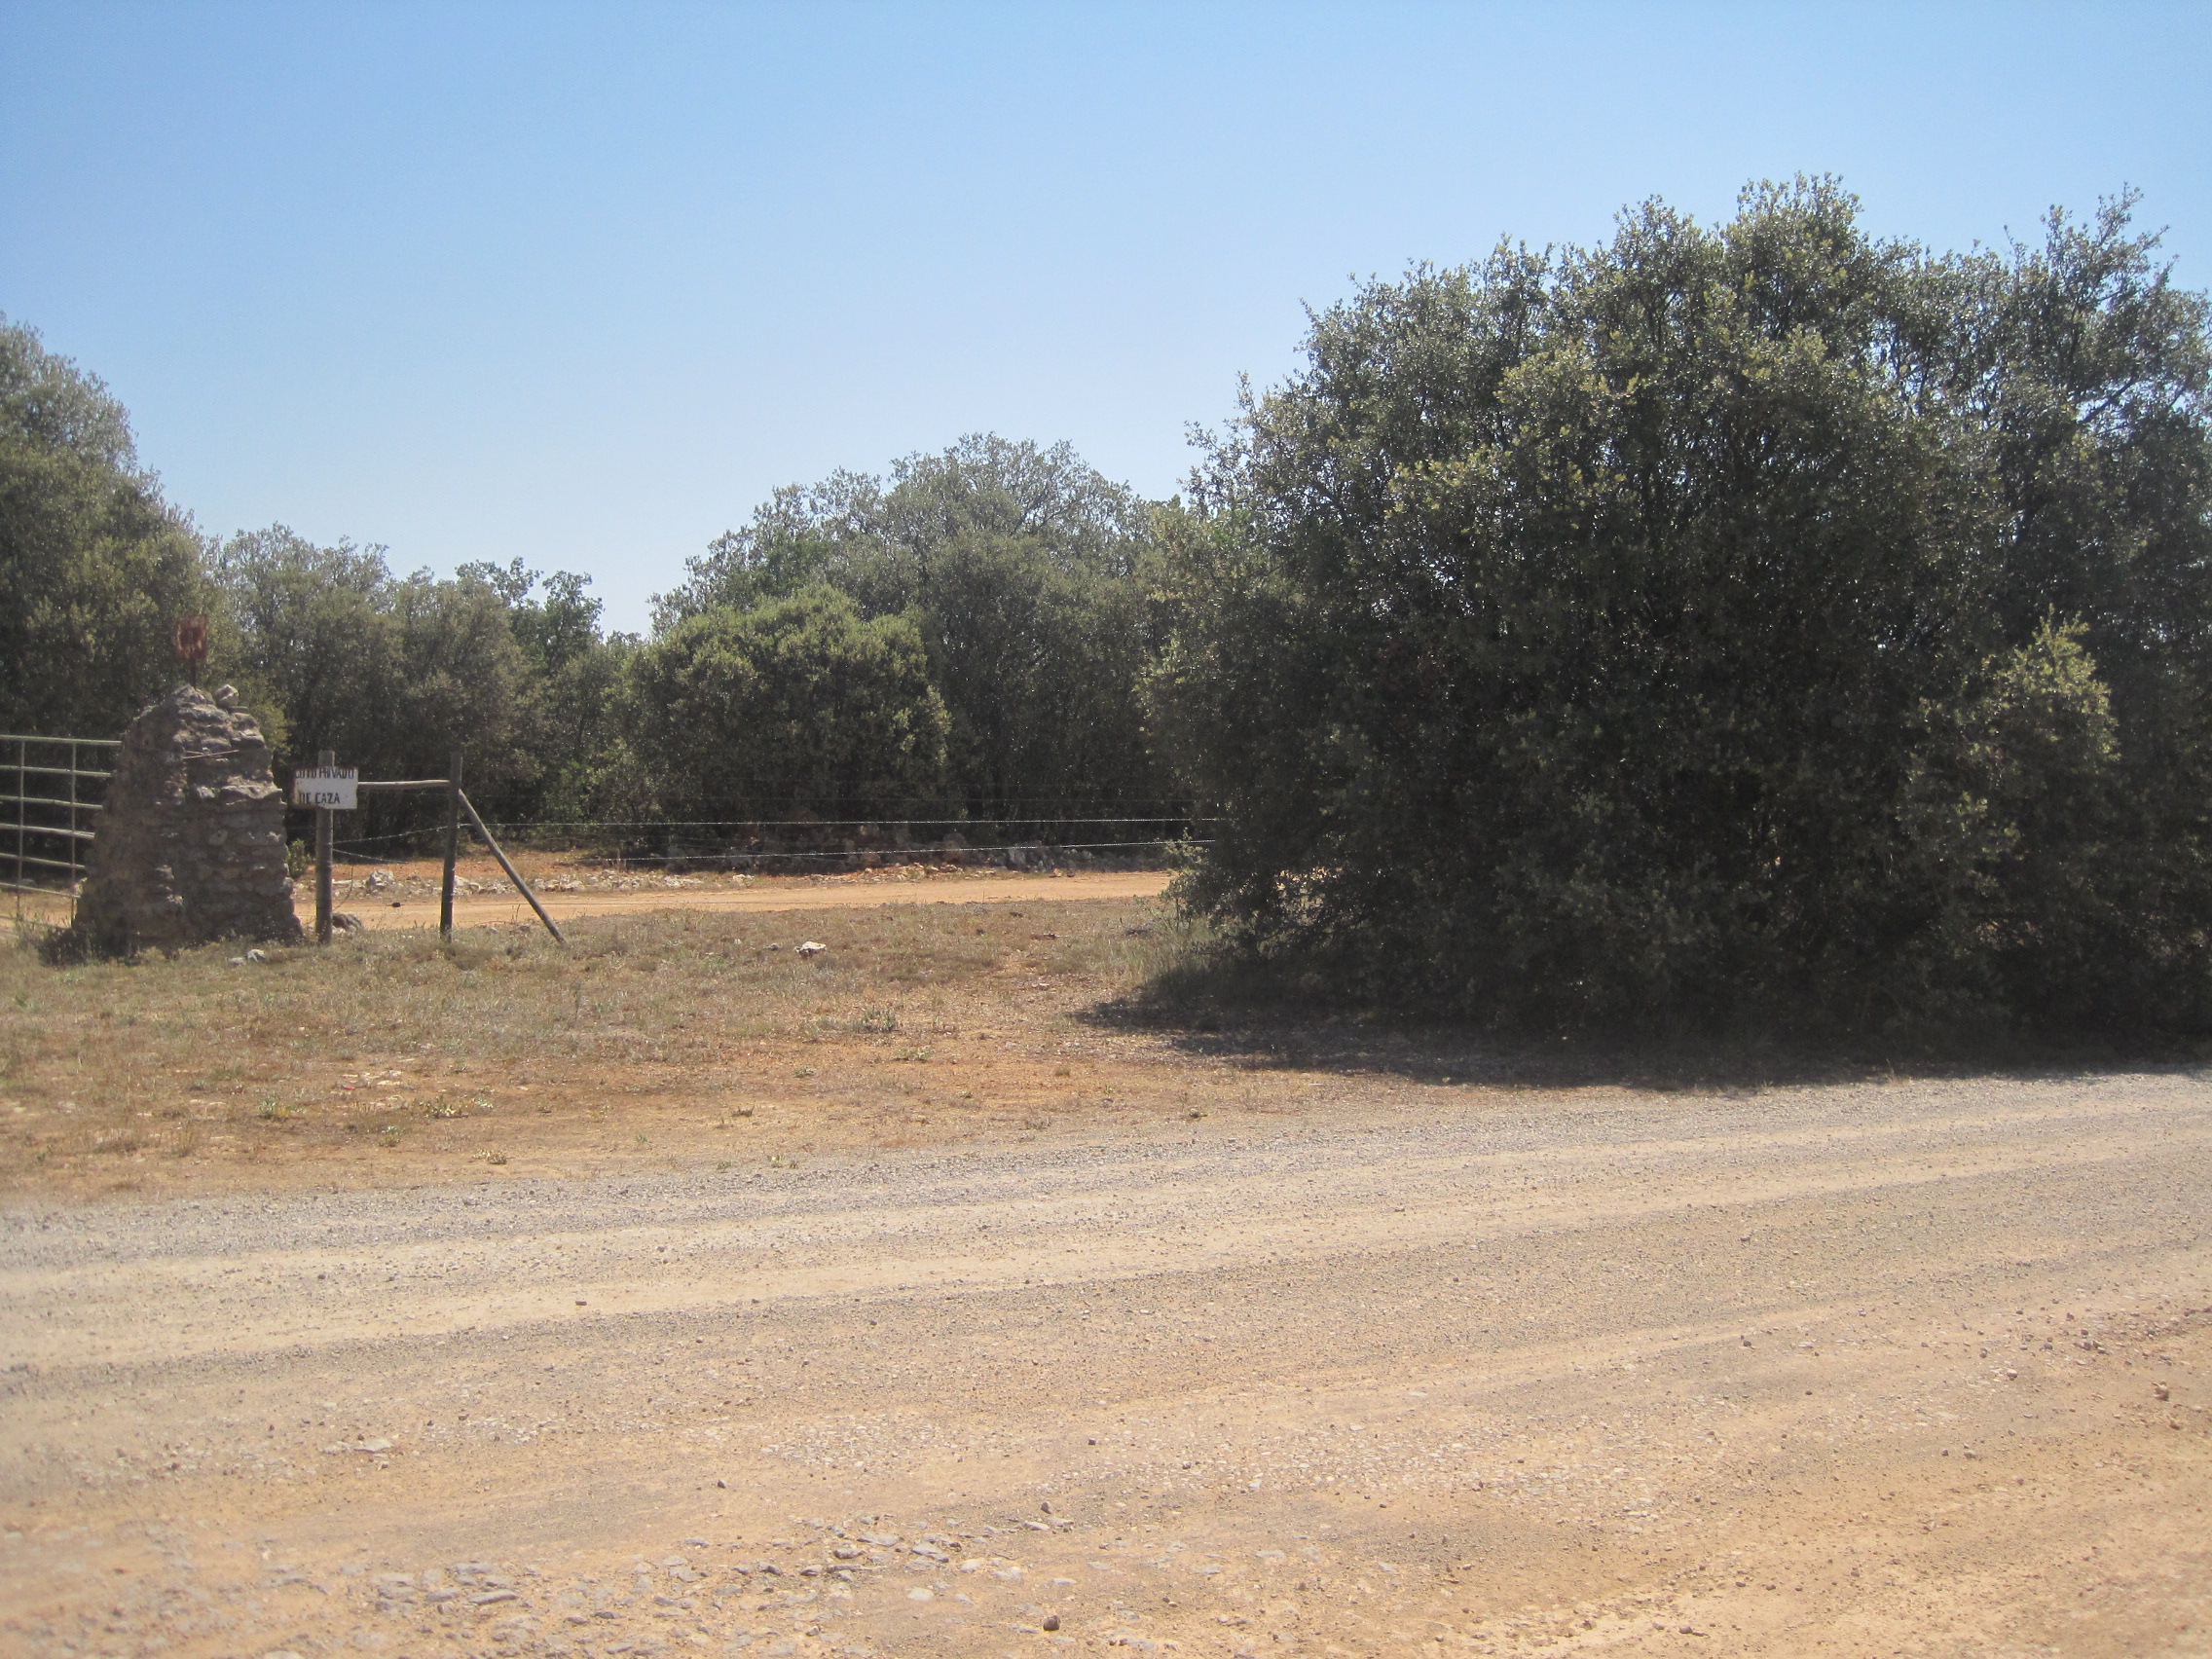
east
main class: Woodland
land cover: Broadleaved woodland
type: broadleaved evergreen forest
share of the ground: 50 - 75 %
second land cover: Grassland without tree/shrub cover
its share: 50 - 75 %
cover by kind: broadleaved forest trees 70 %, herbaceous plants 30 %
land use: Forestry
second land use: Agriculture (excluding fallow land and kitchen gardens)
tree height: > 5 m
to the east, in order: Broadleaved woodland; Grassland without tree/shrub cover; Tracks; Broadleaved woodland; Fences; Tracks; Grassland with sparse tree/shrub cover; Tracks
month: July
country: ES
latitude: 41.7672
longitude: -5.1262
